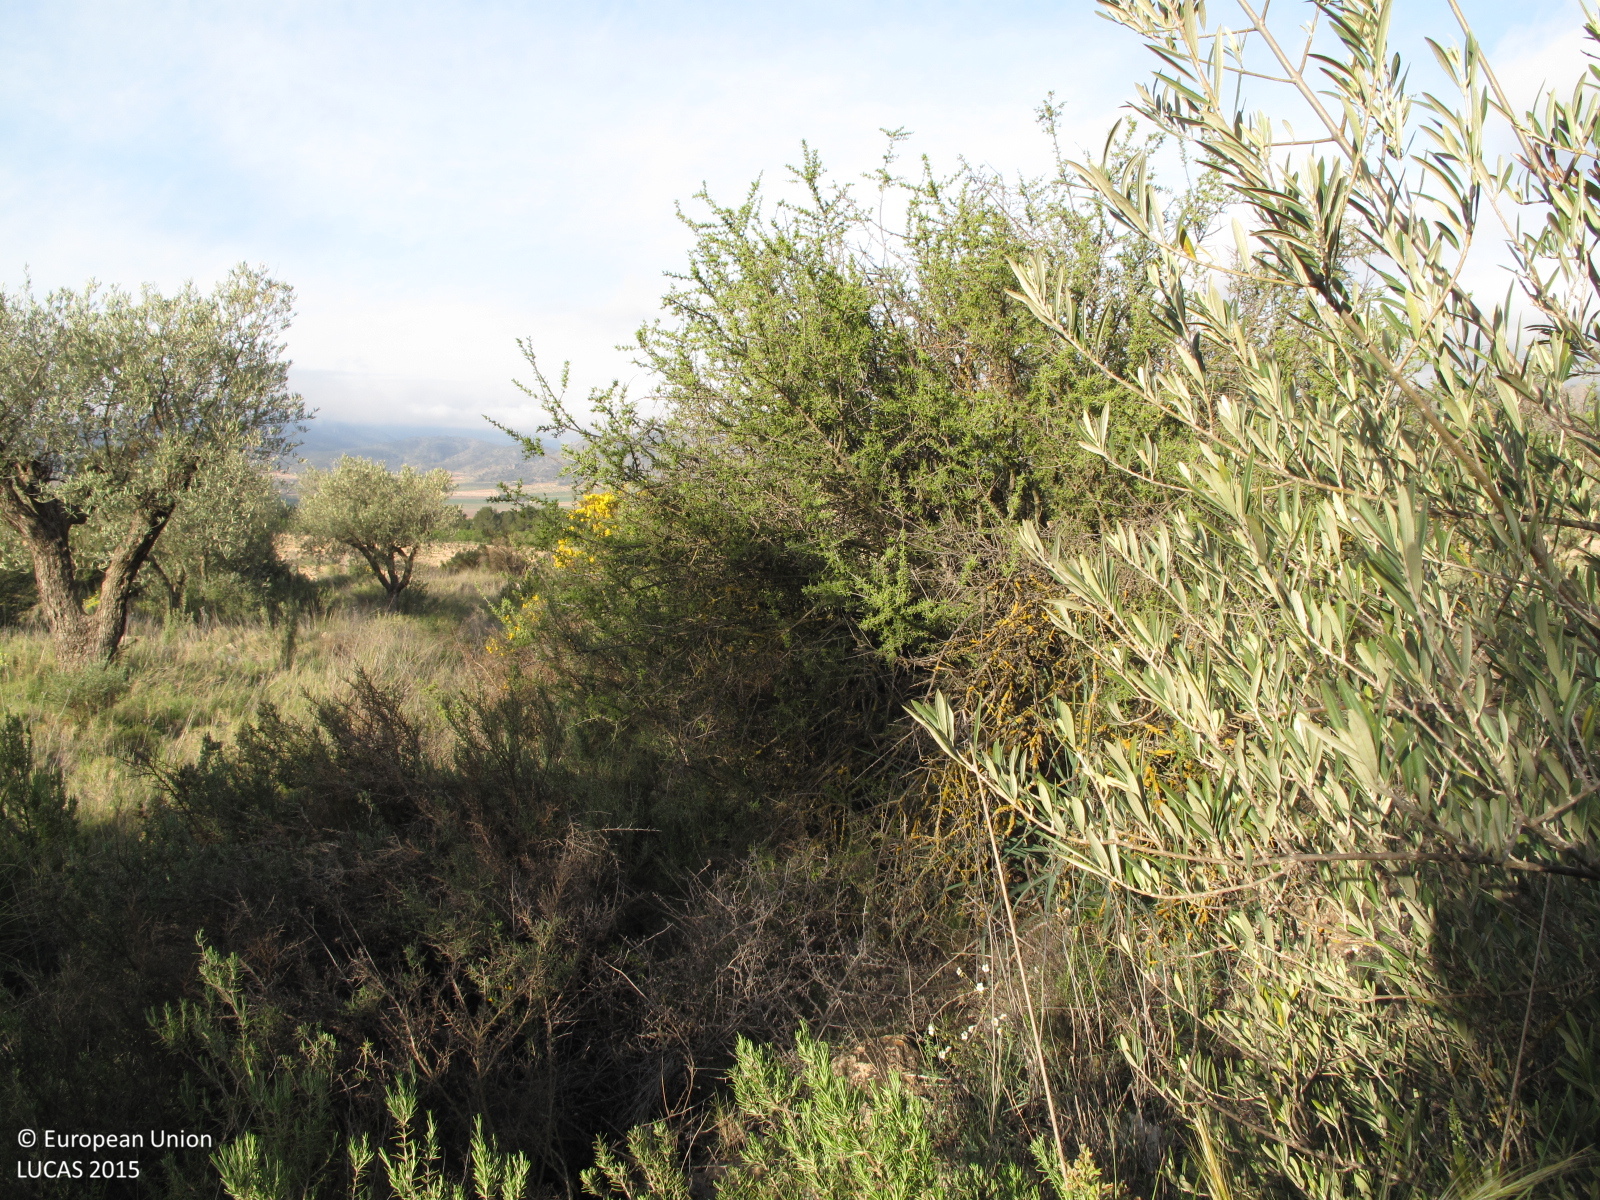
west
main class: Shrubland
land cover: Shrubland with sparse tree cover
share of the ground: > 75 %
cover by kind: shrubs 50 %, herbaceous plants 45 %, broadleaved forest trees 5 %
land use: Semi-natural and natural areas not in use
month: April
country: ES
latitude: 38.5084
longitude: -1.0561
